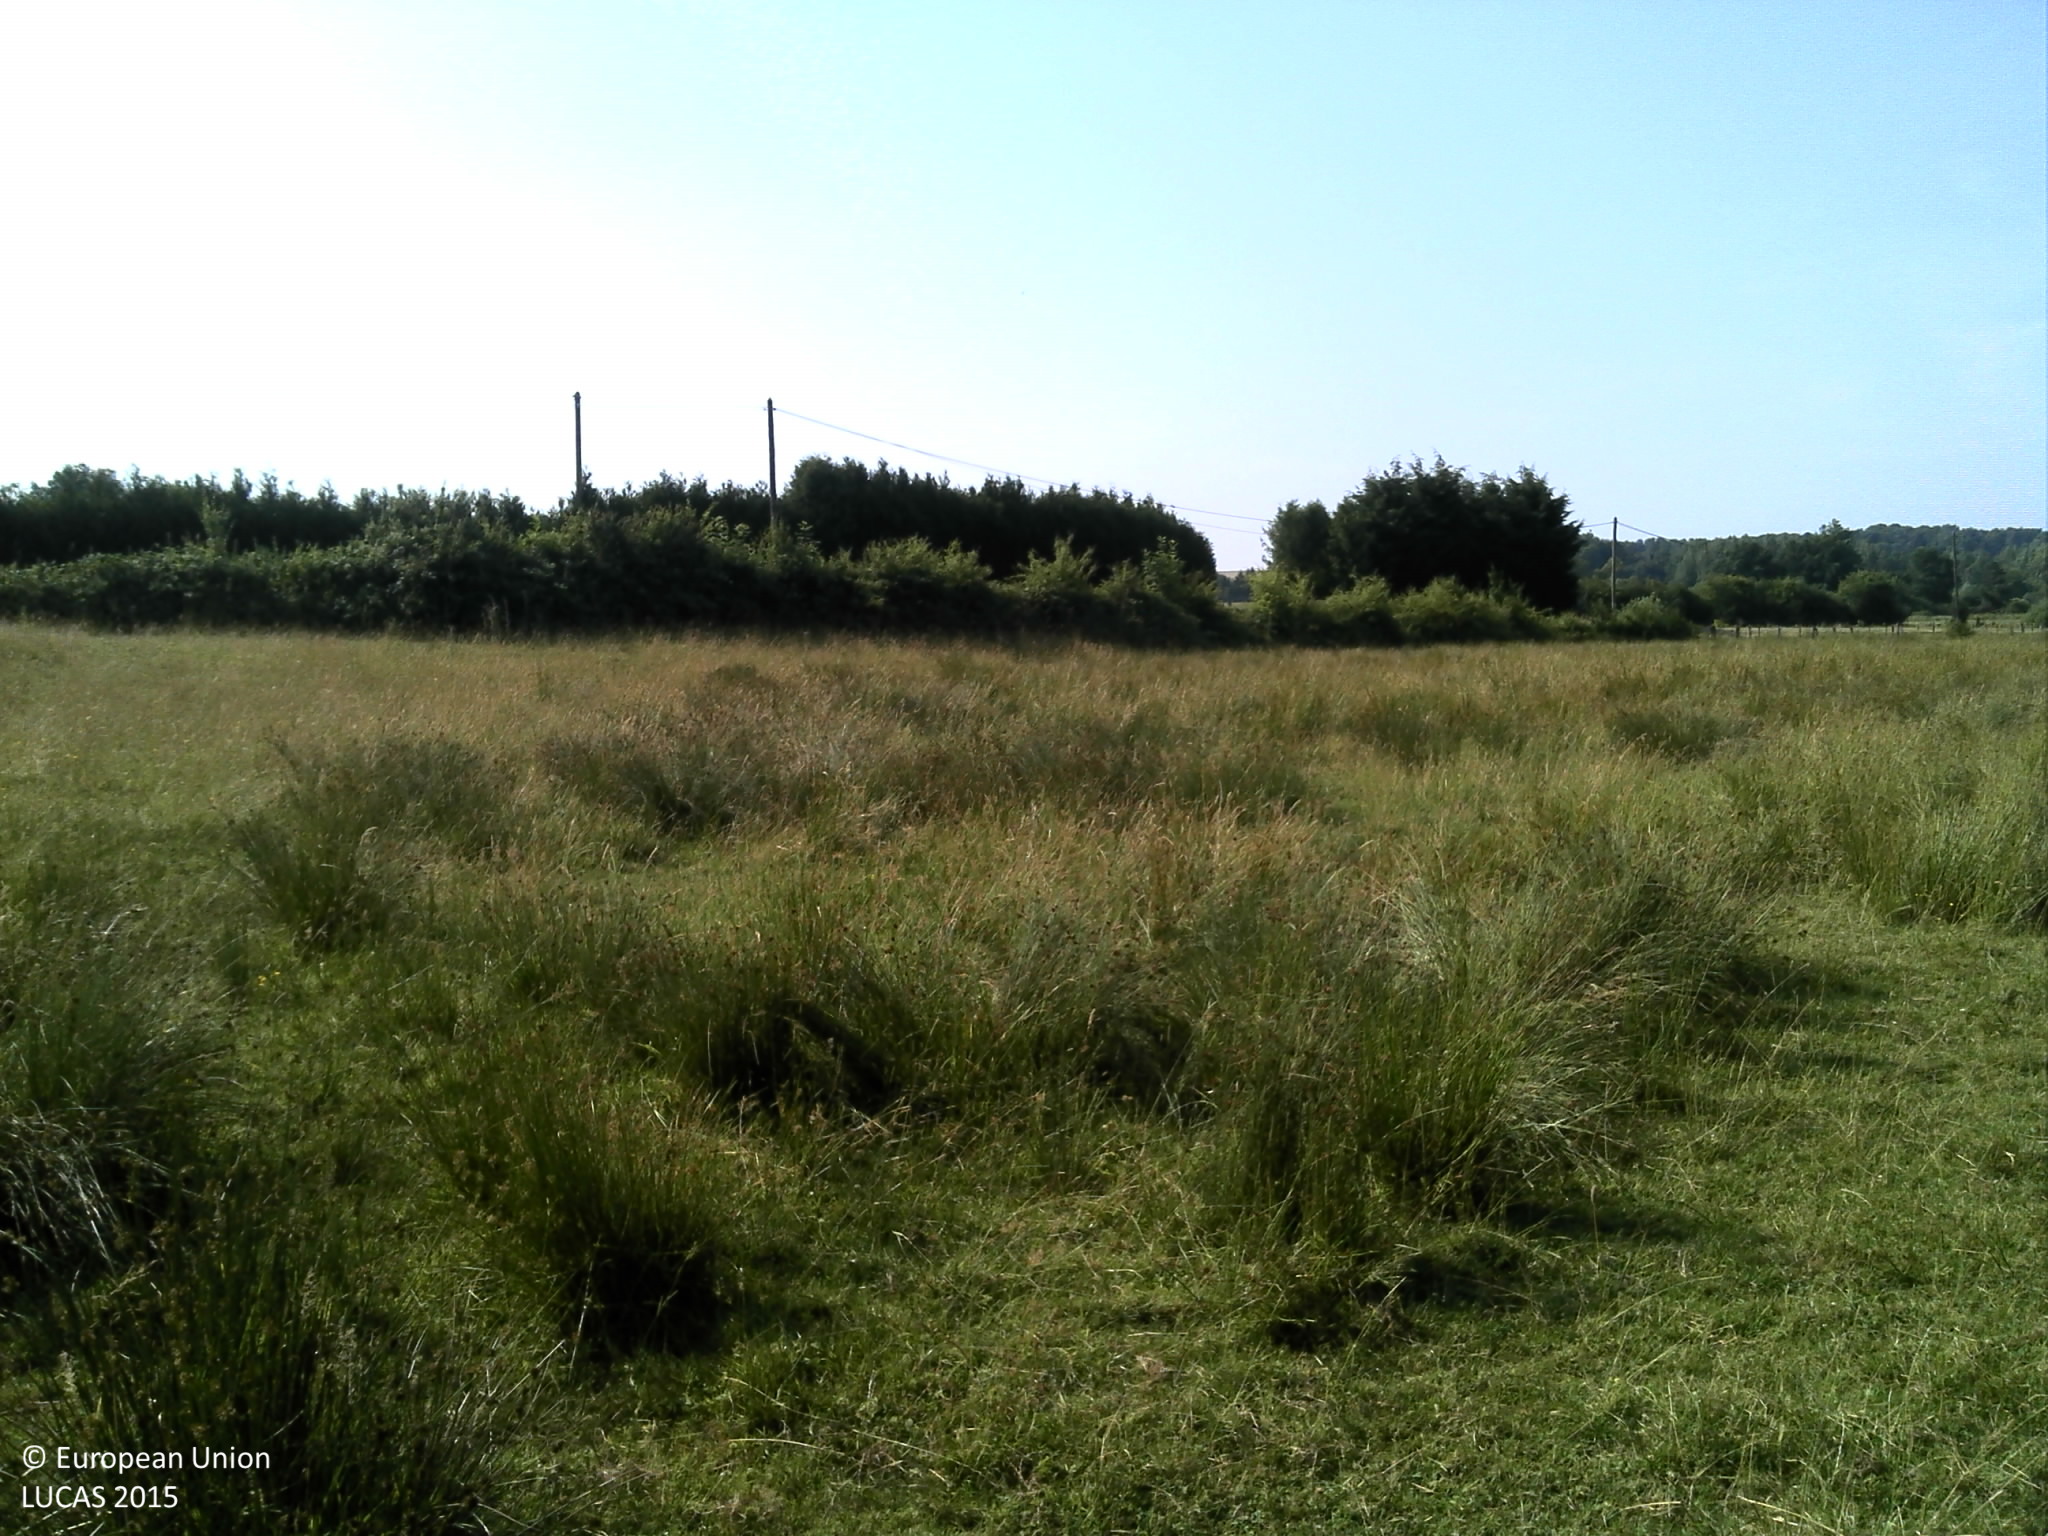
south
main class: Grassland
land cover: Grassland without tree/shrub cover
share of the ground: > 75 %
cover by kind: herbaceous plants 100 %
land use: Agriculture (excluding fallow land and kitchen gardens)
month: July
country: FR
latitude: 49.8341
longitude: 4.4764
